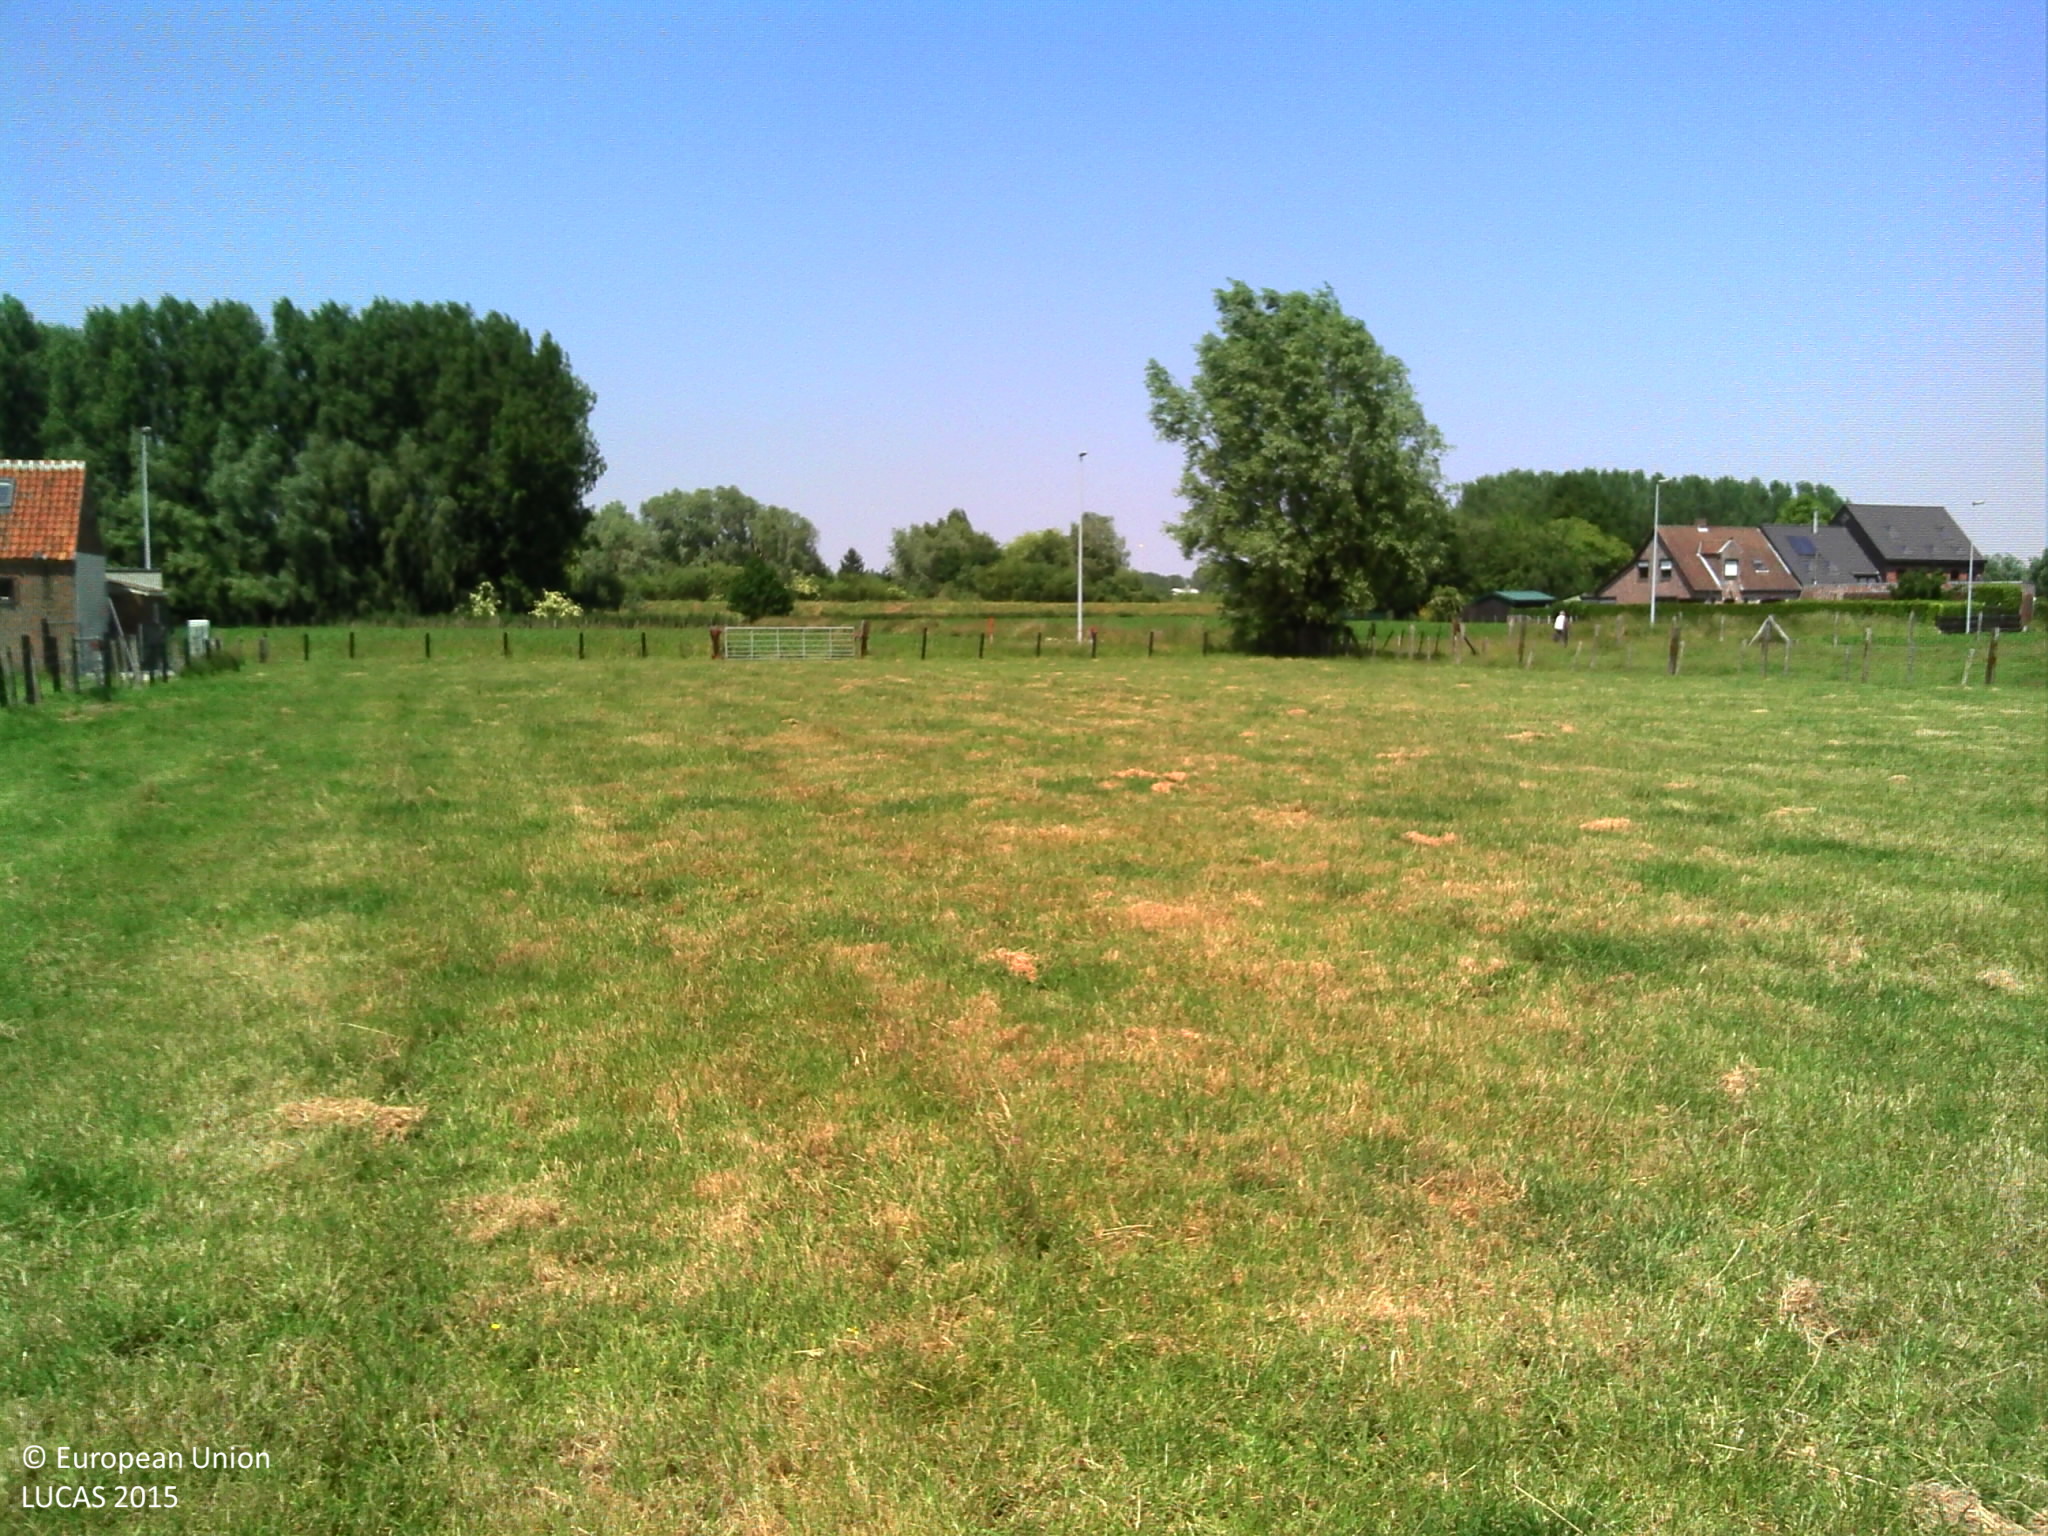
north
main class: Grassland
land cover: Grassland without tree/shrub cover
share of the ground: > 75 %
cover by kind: herbaceous plants 100 %
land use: Agriculture (excluding fallow land and kitchen gardens)
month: June
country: BE
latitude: 51.0921
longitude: 4.0403
